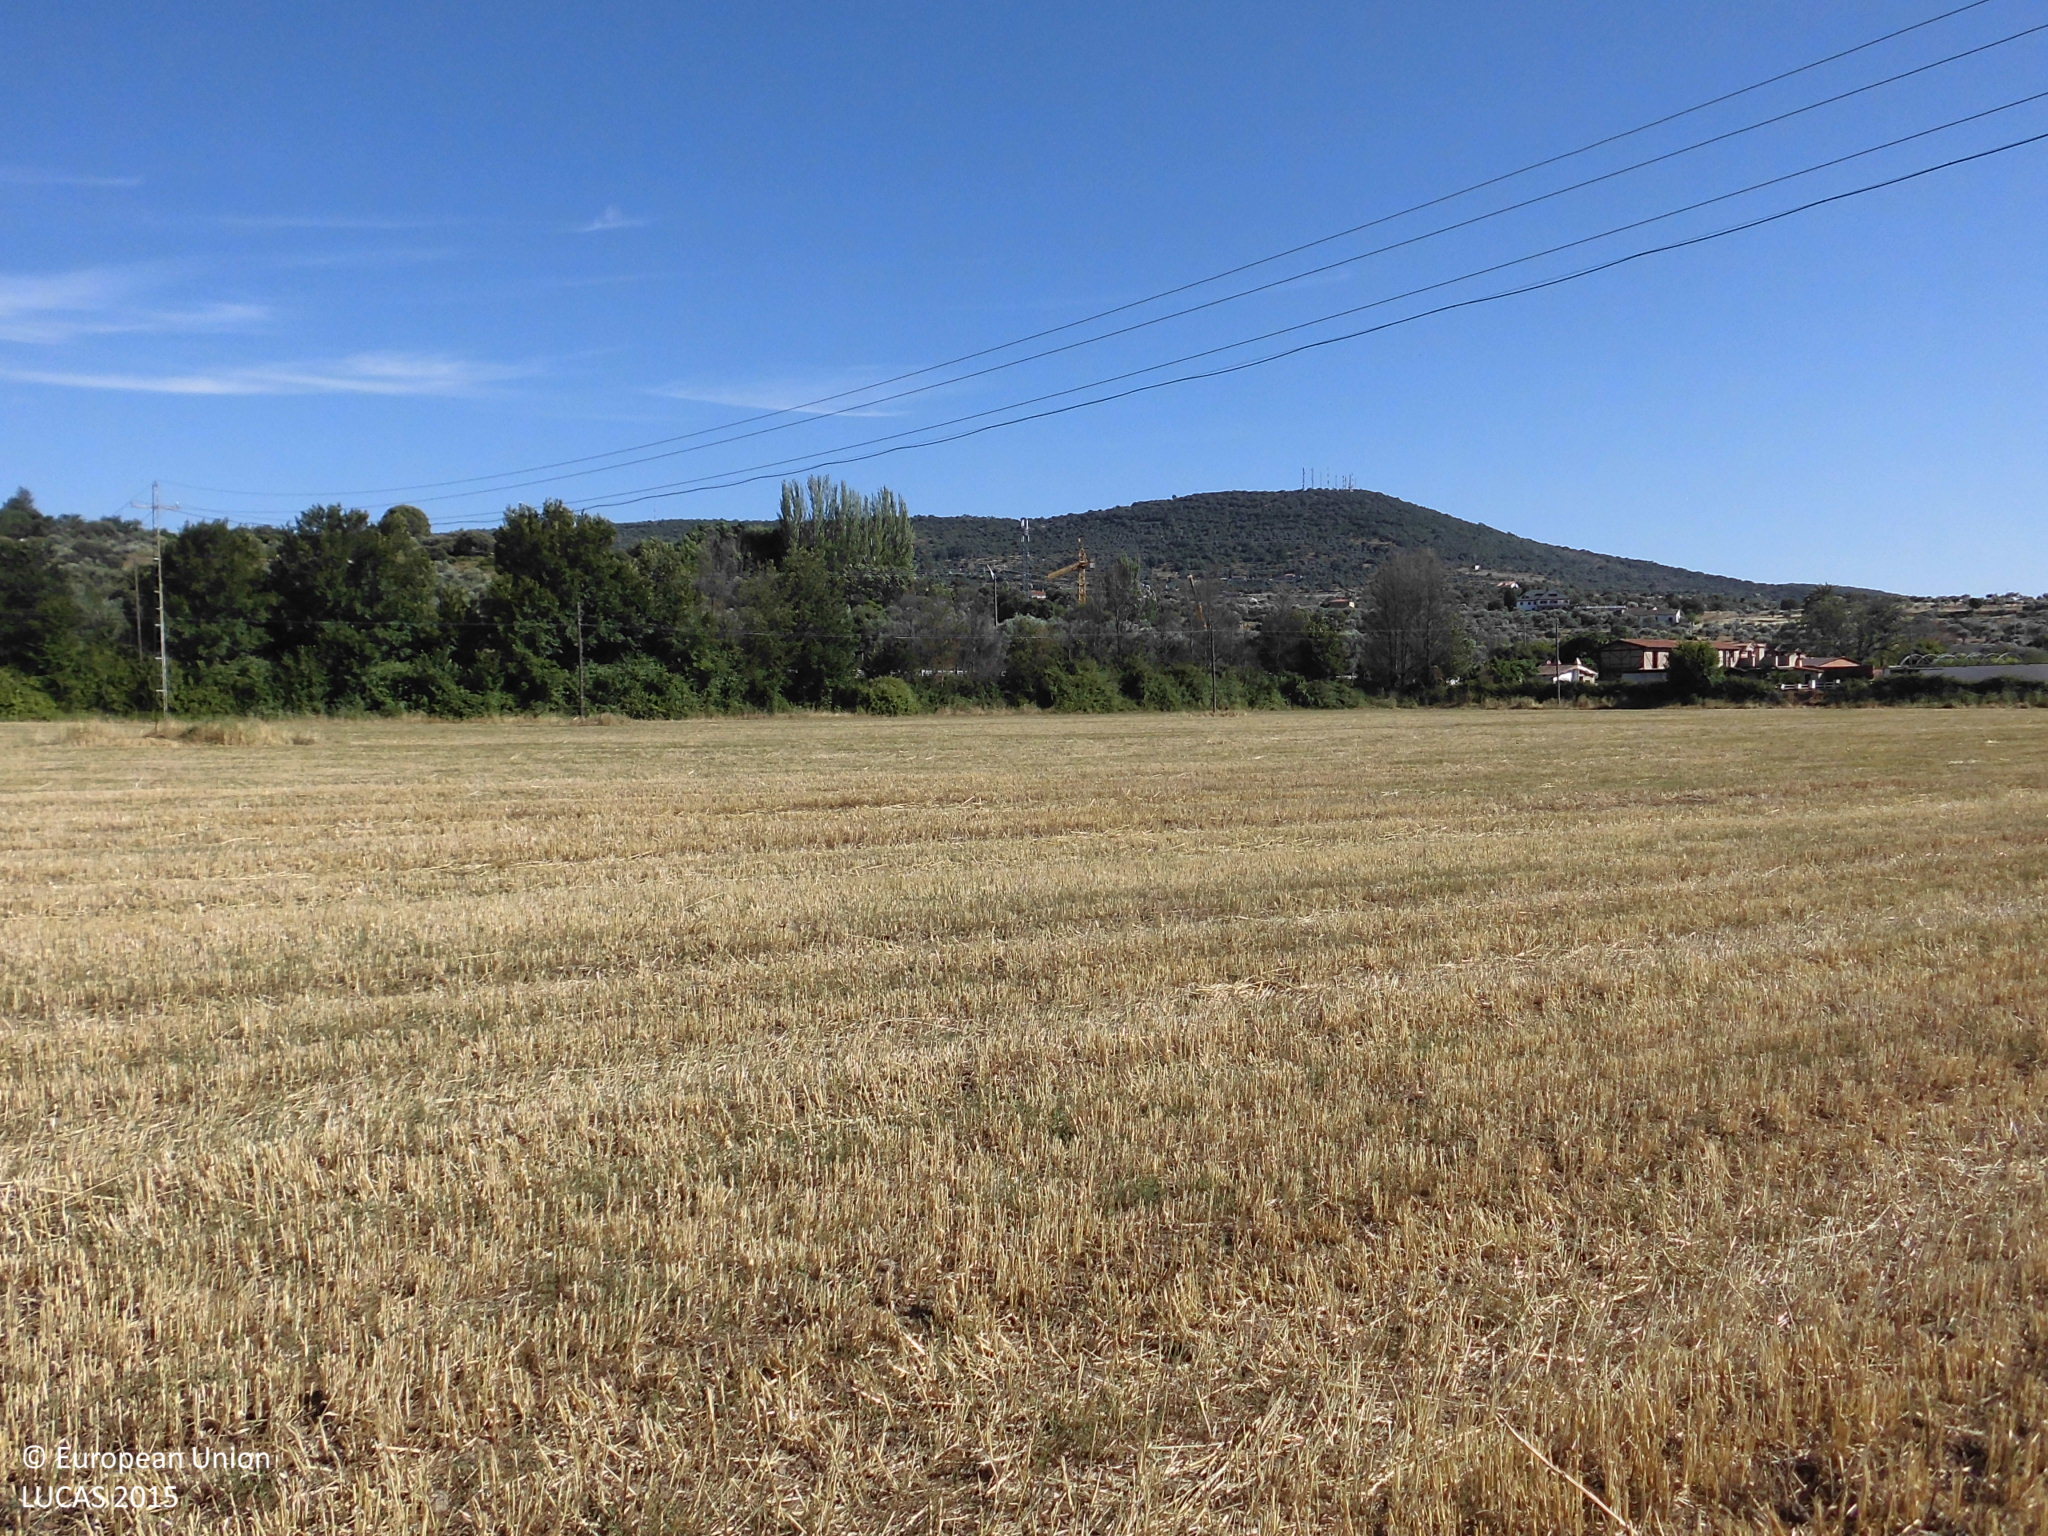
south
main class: Cropland
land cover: Oats
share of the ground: 50 - 75 %
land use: Agriculture (excluding fallow land and kitchen gardens)
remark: Harvested field
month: June
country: ES
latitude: 40.0373
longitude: -6.0685
